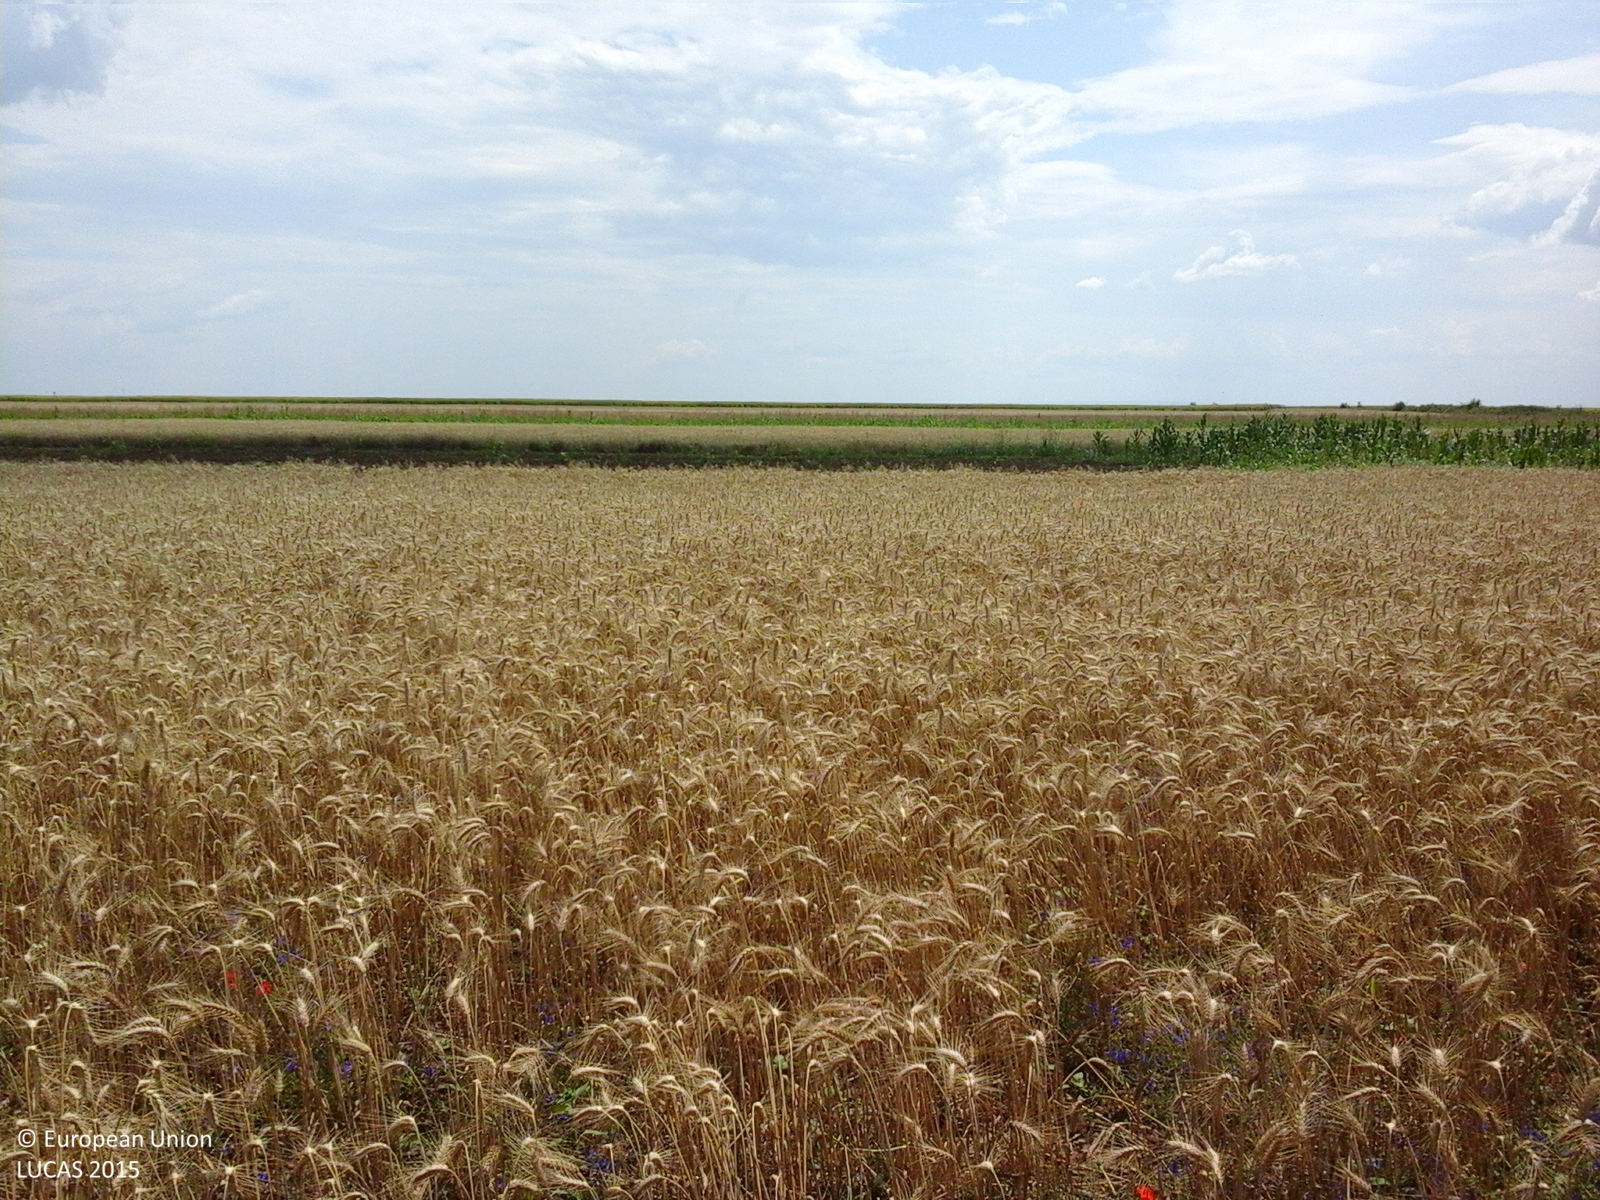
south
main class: Cropland
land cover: Common wheat
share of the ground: > 75 %
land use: Agriculture (excluding fallow land and kitchen gardens)
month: July
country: RO
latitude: 43.9577
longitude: 24.5606
